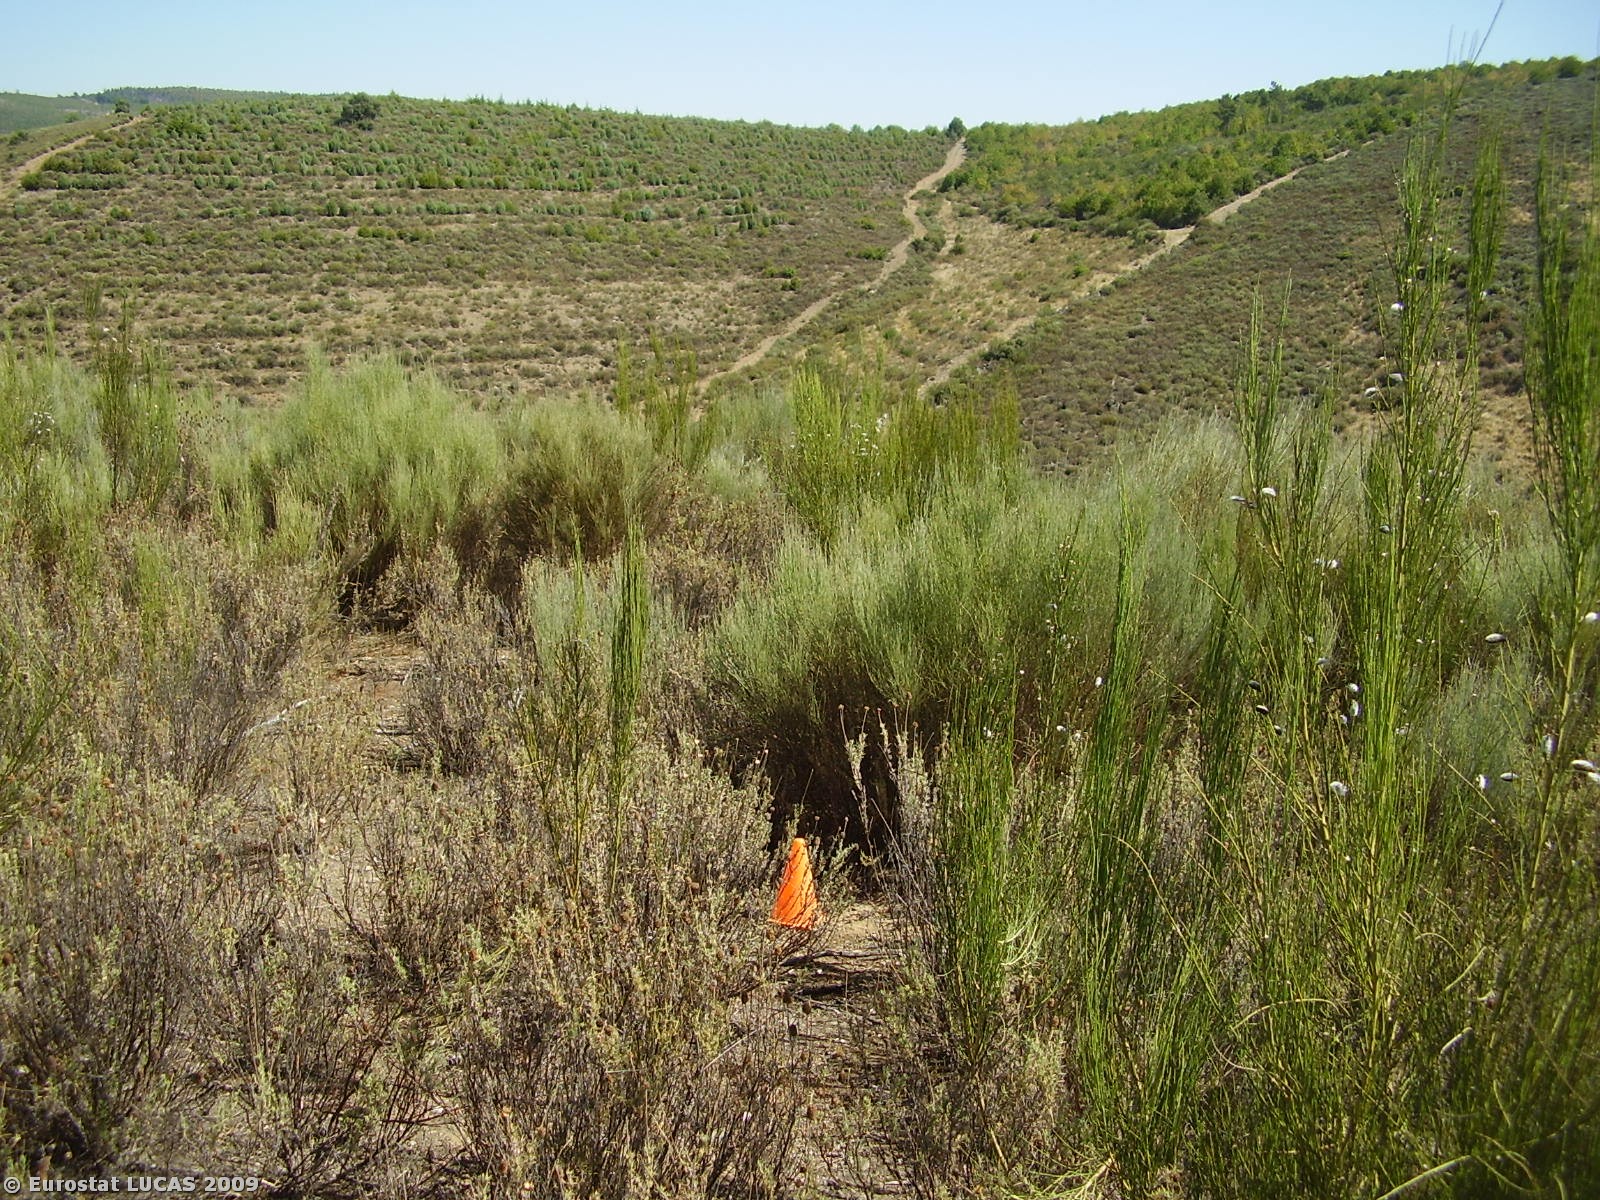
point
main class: Shrubland
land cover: Shrubland without tree cover
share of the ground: > 75 %
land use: Fallow land
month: August
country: PT
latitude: 41.2296
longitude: -6.7467
